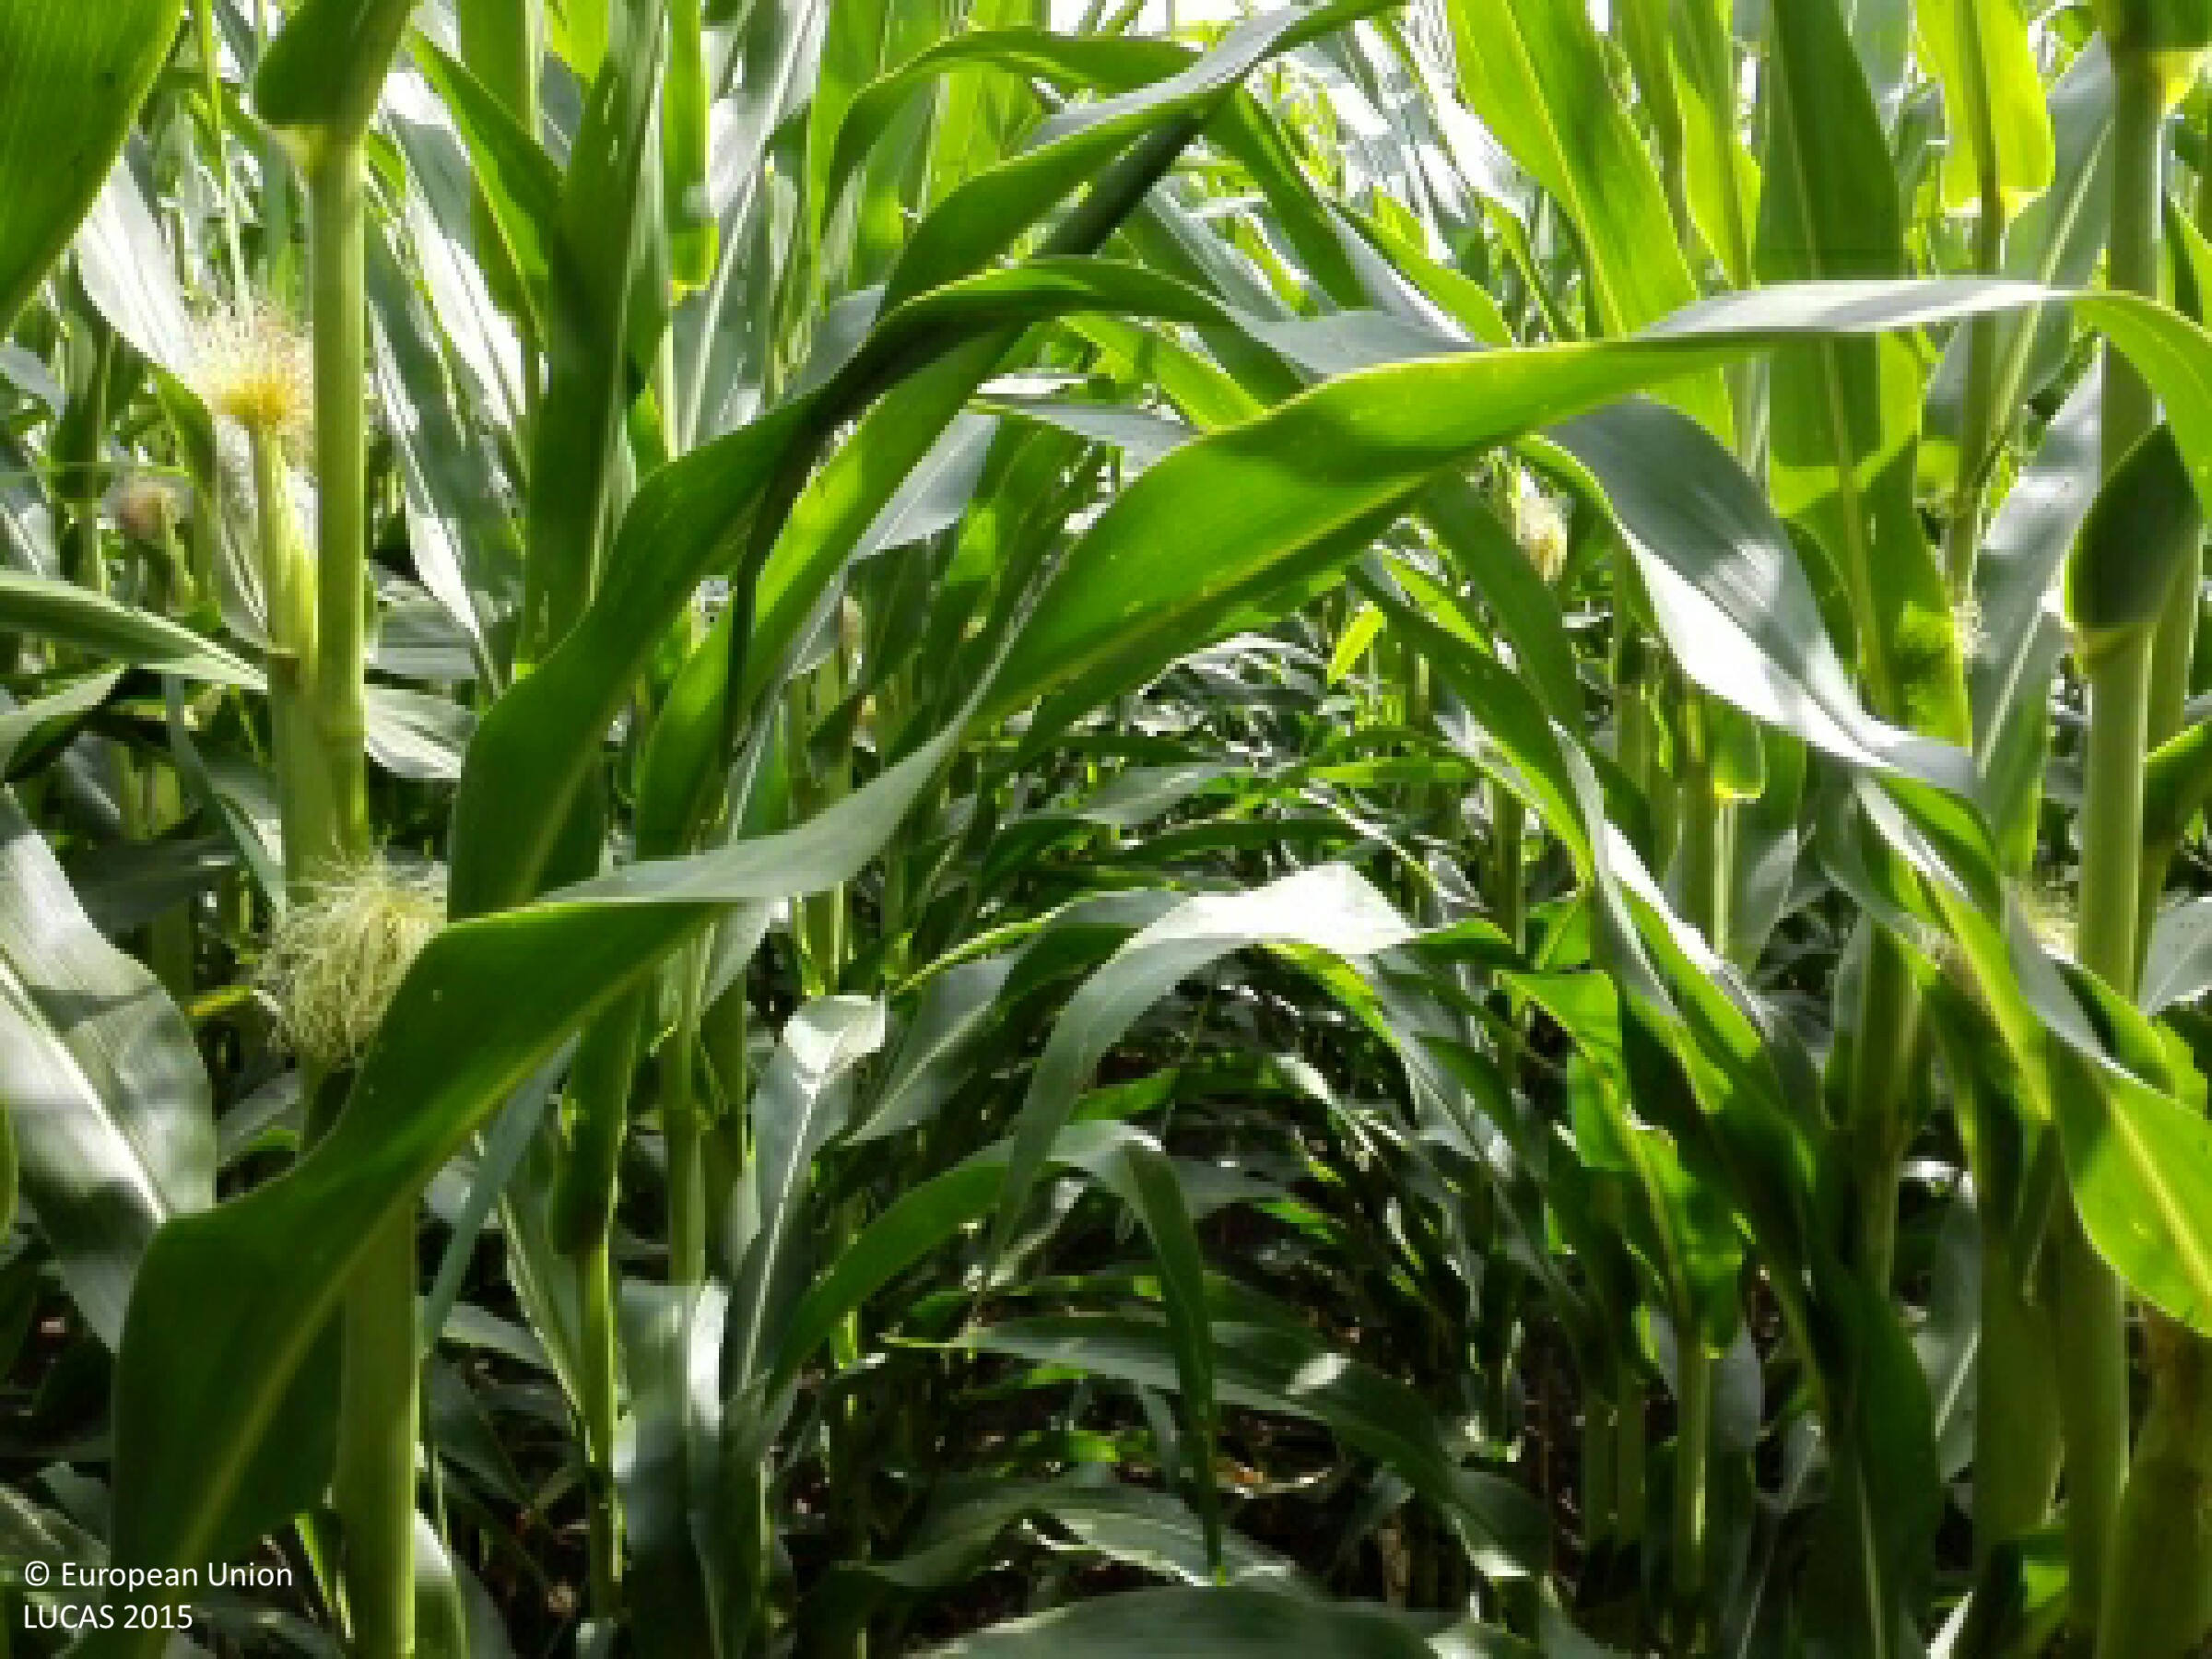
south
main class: Cropland
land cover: Maize
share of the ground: > 75 %
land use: Agriculture (excluding fallow land and kitchen gardens)
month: July
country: HU
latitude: 47.5446
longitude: 21.3479
